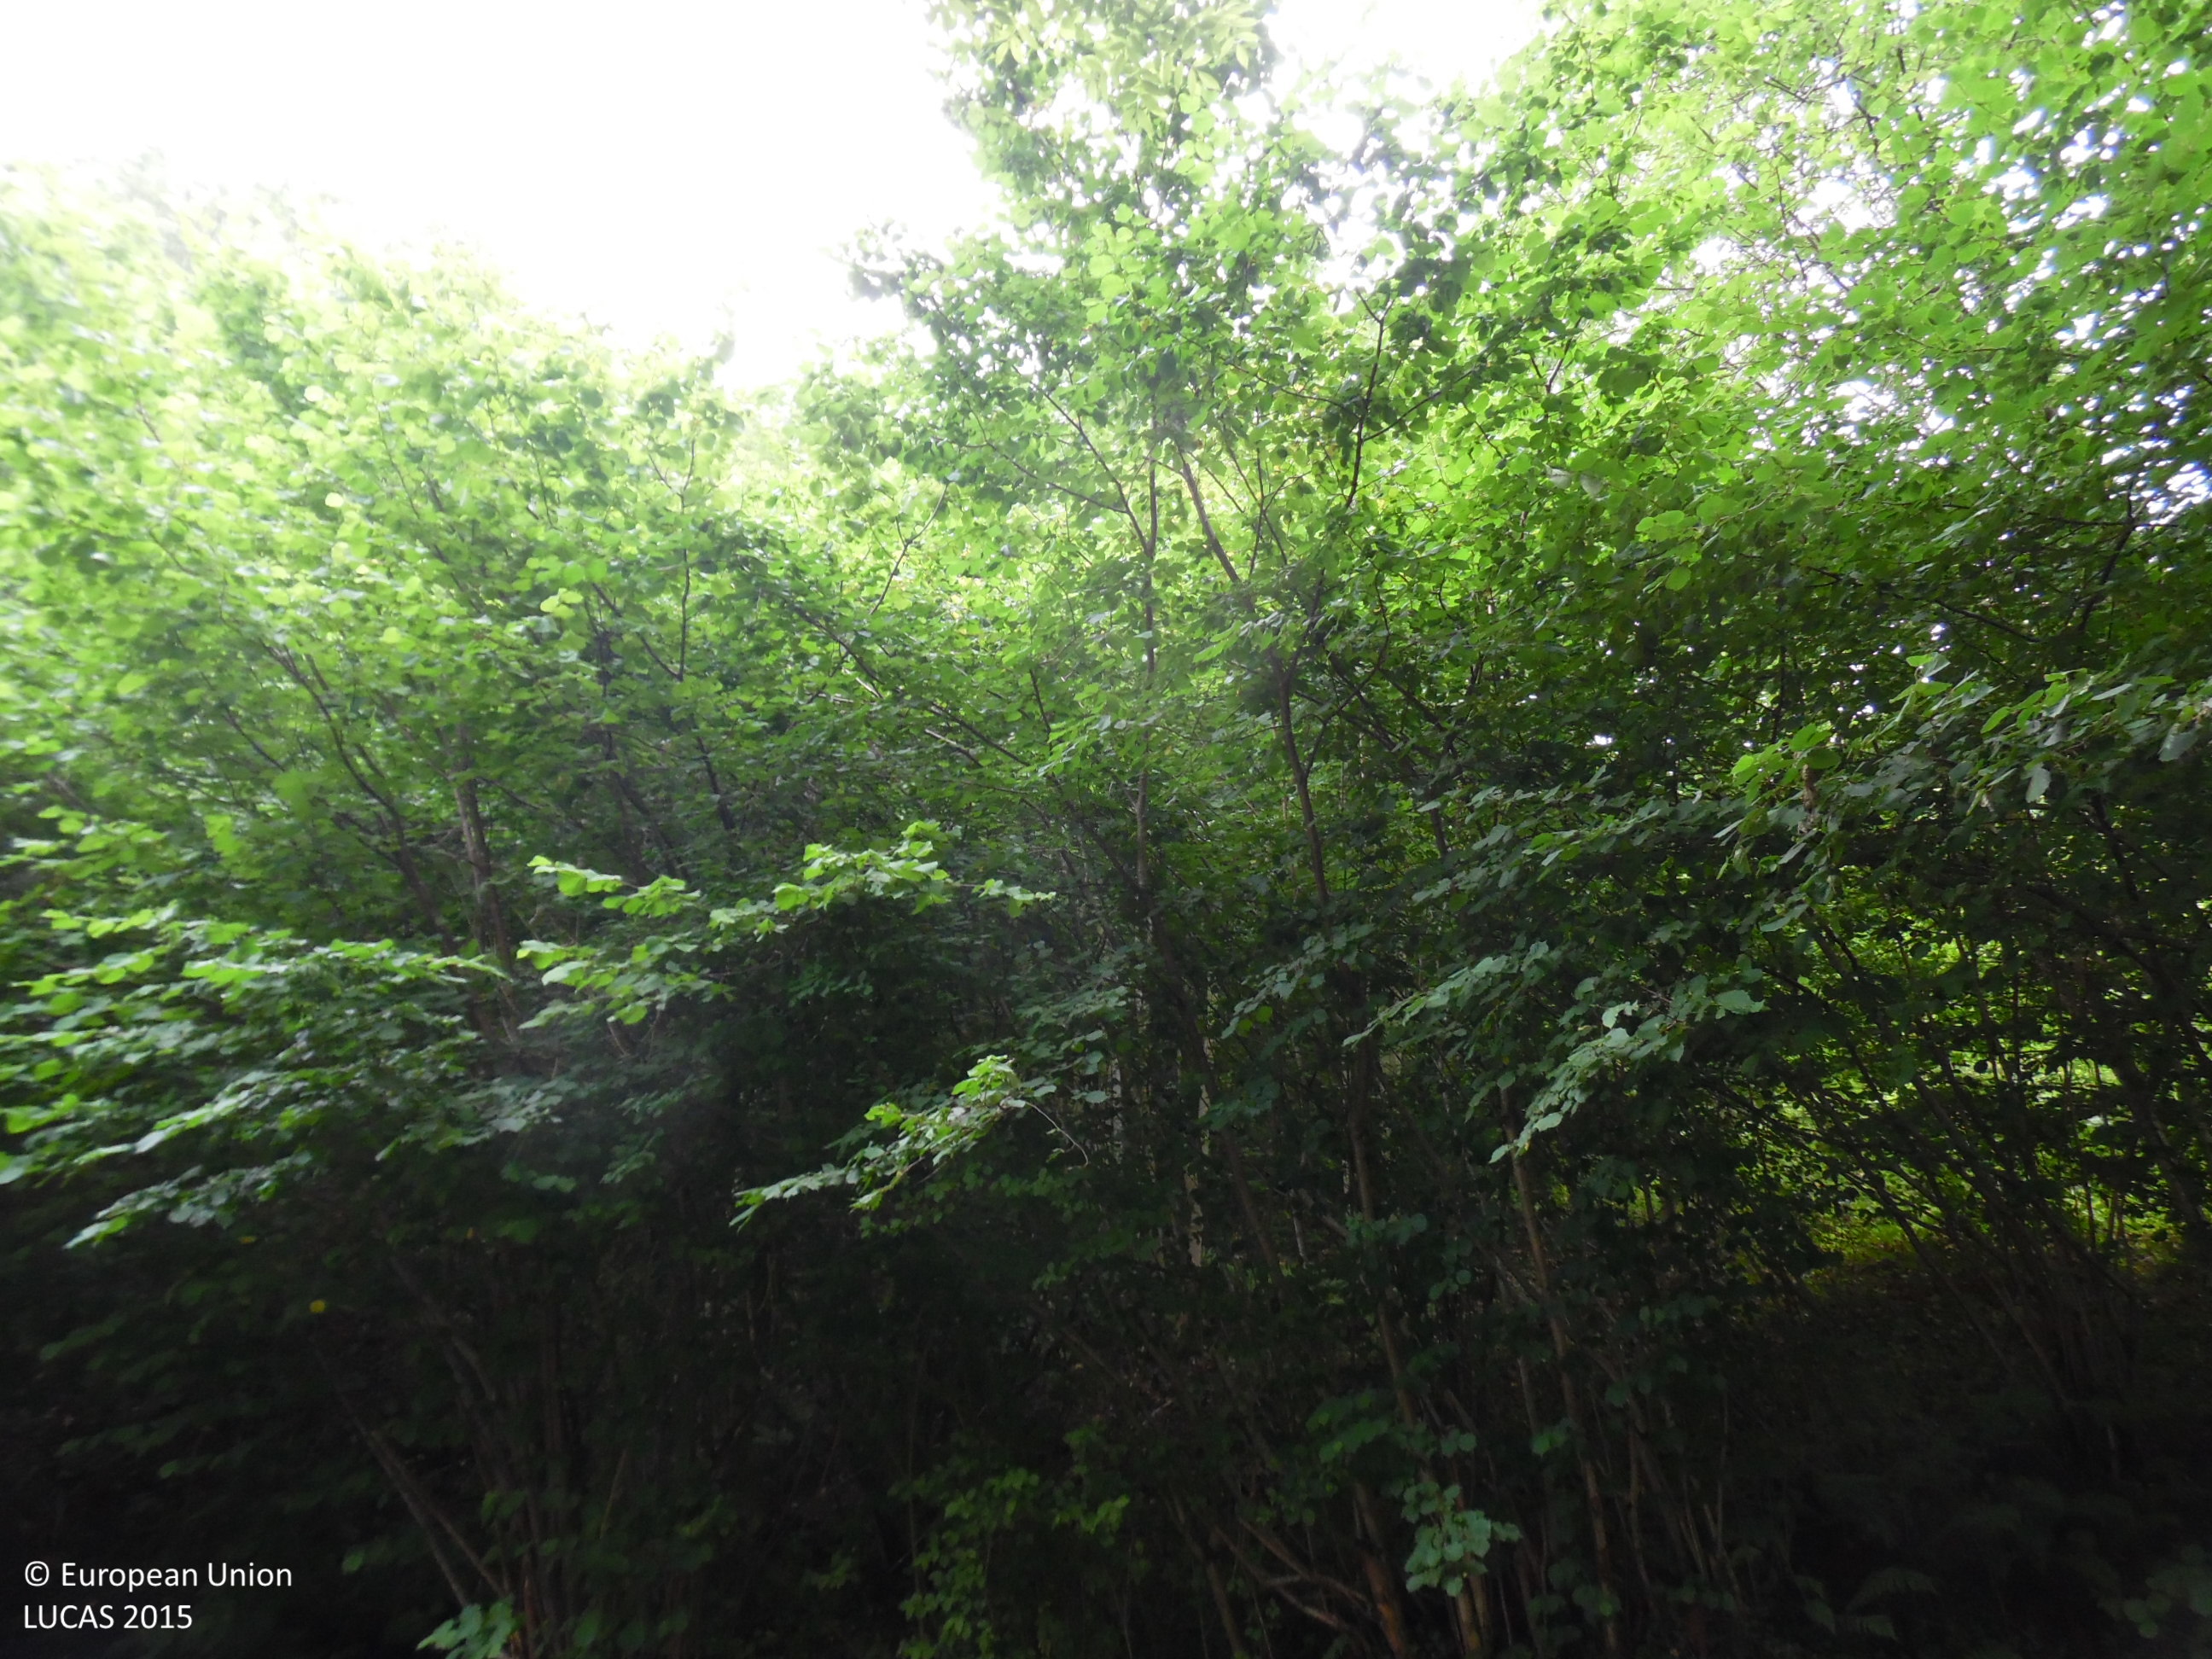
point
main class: Woodland
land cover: Broadleaved woodland
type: thermophilous deciduous forest
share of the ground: > 75 %
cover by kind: broadleaved forest trees 100 %
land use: Forestry
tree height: > 5 m
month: July
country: ES
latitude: 43.0343
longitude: -5.8305
